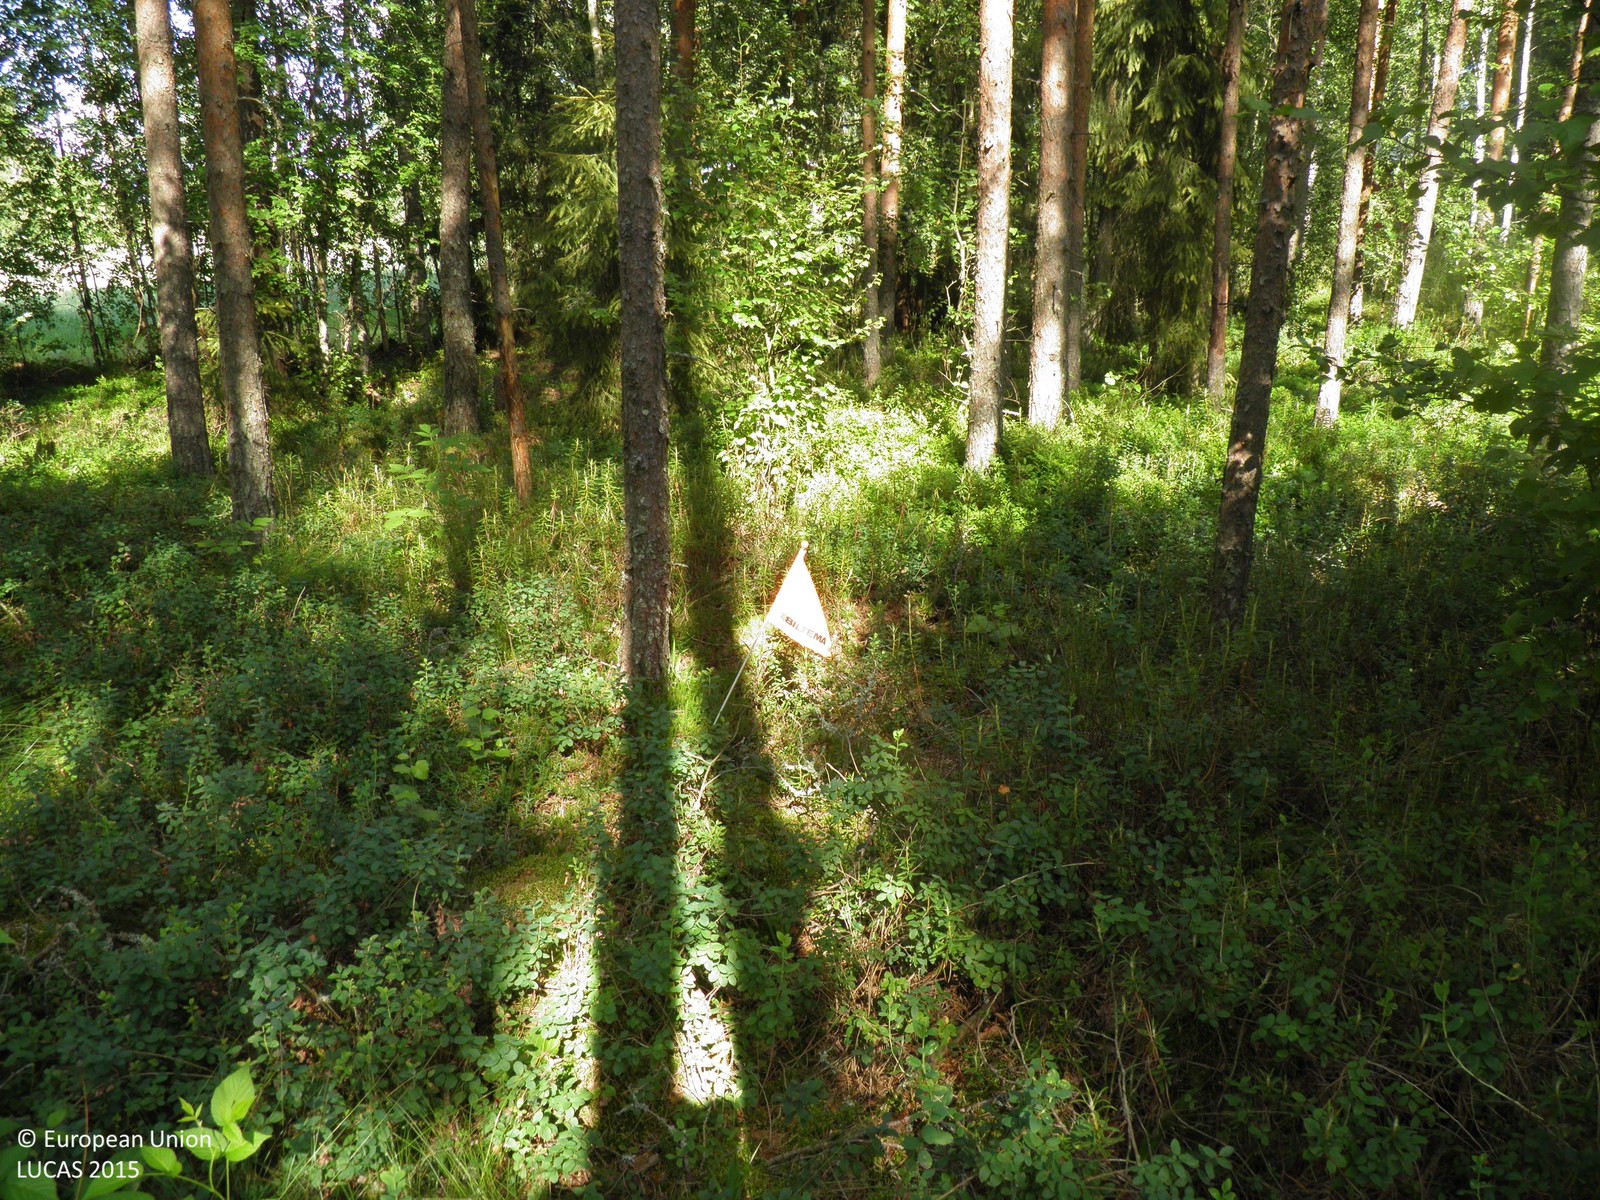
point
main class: Woodland
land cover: Pine dominated coniferous woodland
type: hemiboreal forest and nemoral coniferous forest and mixed broadleaved-coniferous forest
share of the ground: > 75 %
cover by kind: coniferous forest trees 75 %, shrubs 10 %, broadleaved forest trees 5 %, herbaceous plants 5 %, lichens and mosses 5 %
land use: Forestry
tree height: > 5 m
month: August
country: FI
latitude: 61.0099
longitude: 23.1166
